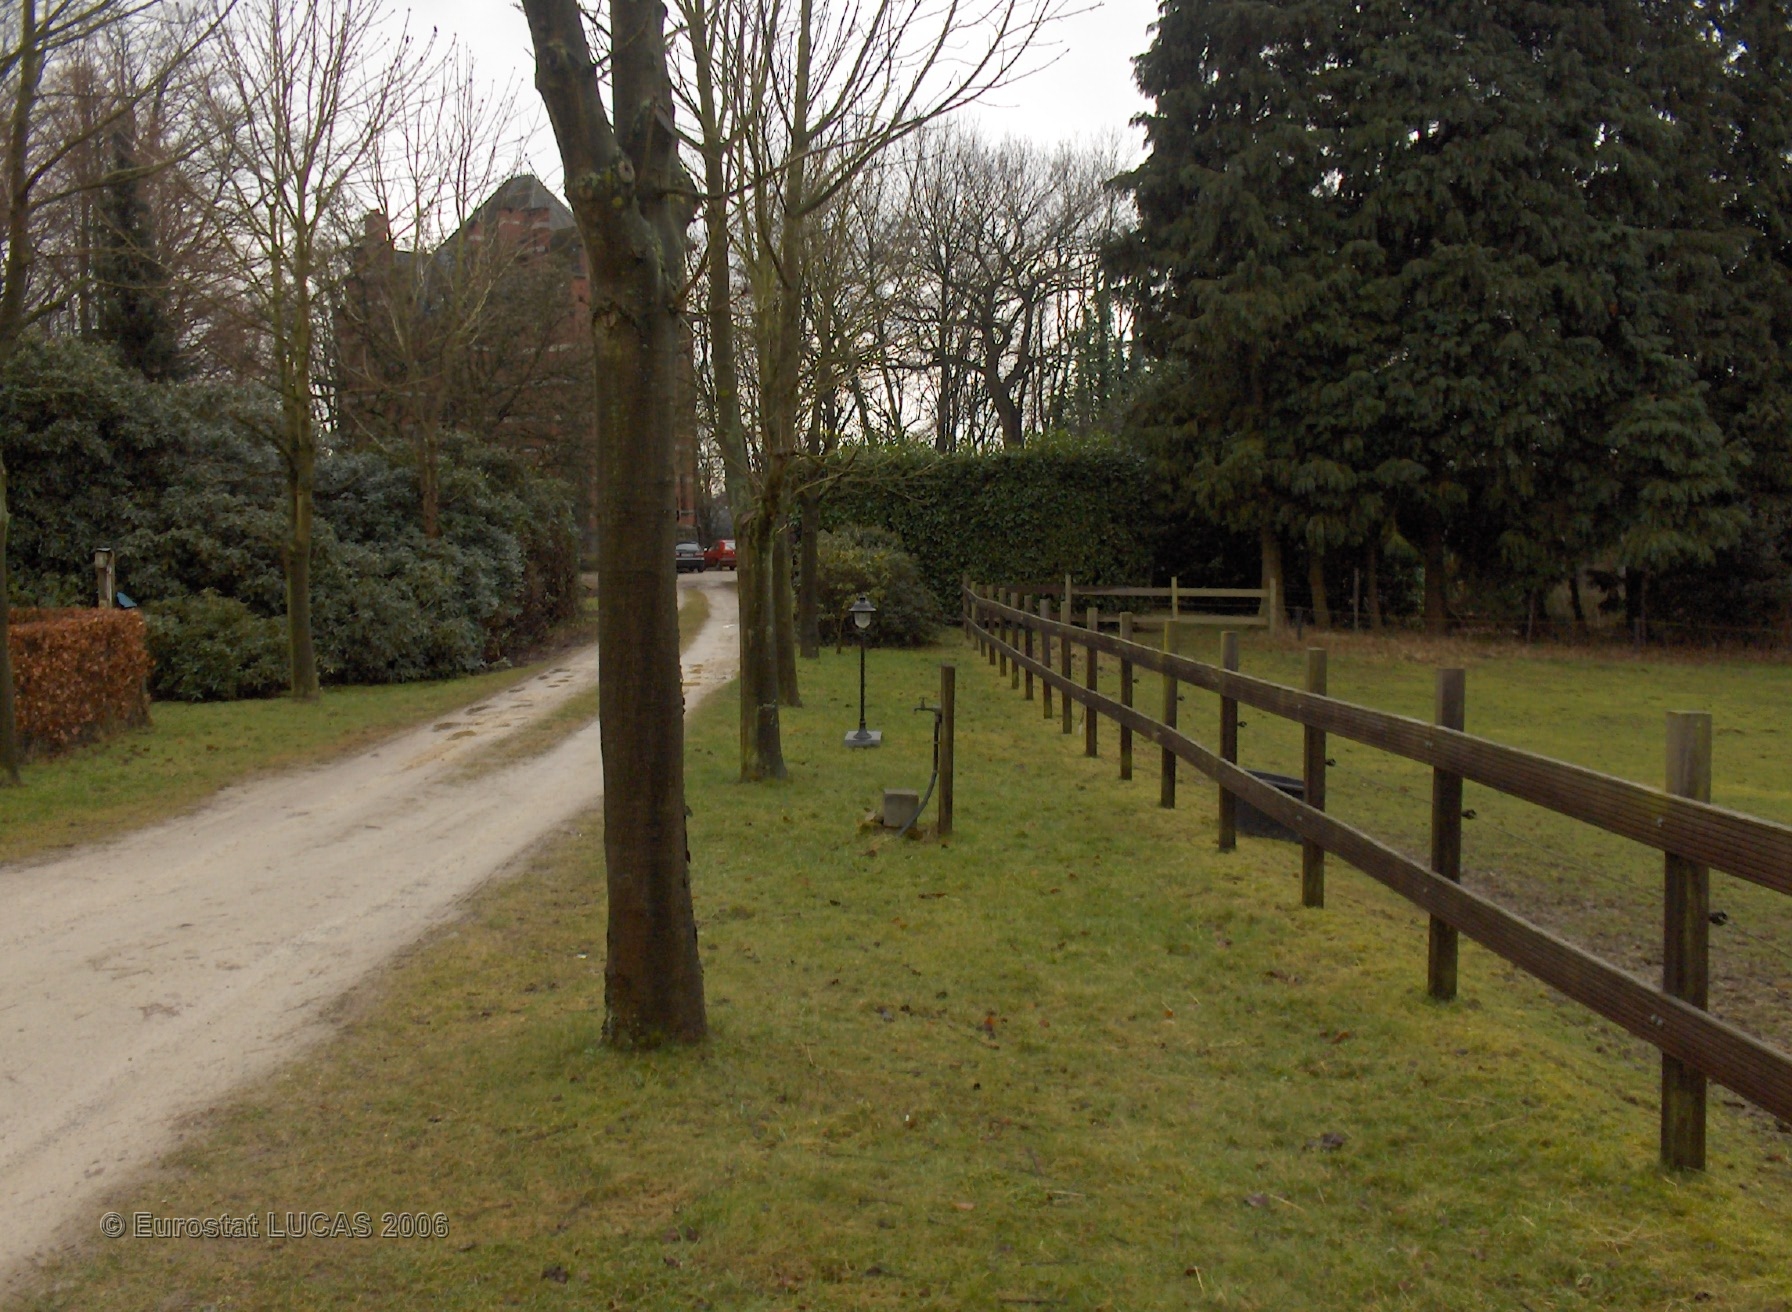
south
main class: Grassland
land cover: Grassland with sparse tree/shrub cover
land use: Agriculture (excluding fallow land and kitchen gardens)
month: February
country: BE
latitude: 50.7715
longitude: 4.4797
